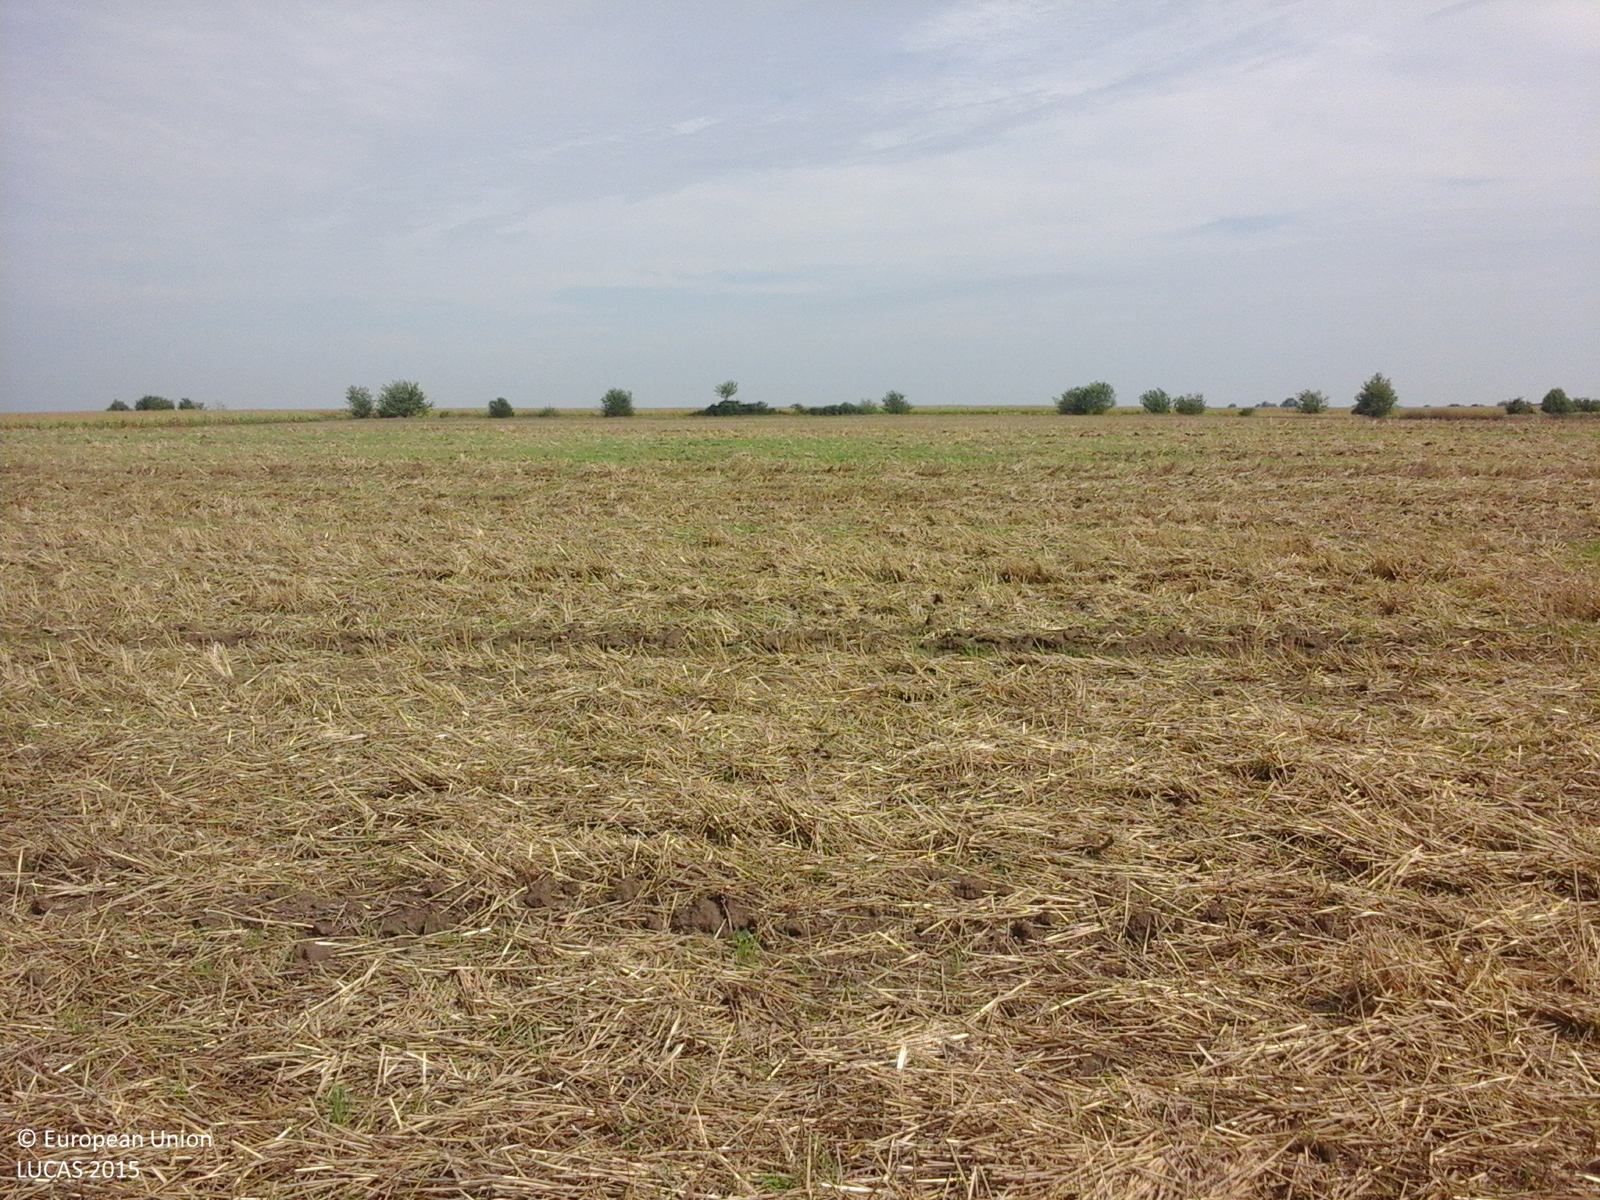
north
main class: Cropland
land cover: Common wheat
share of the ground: 50 - 75 %
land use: Agriculture (excluding fallow land and kitchen gardens)
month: August
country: RO
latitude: 46.1644
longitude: 20.8162
